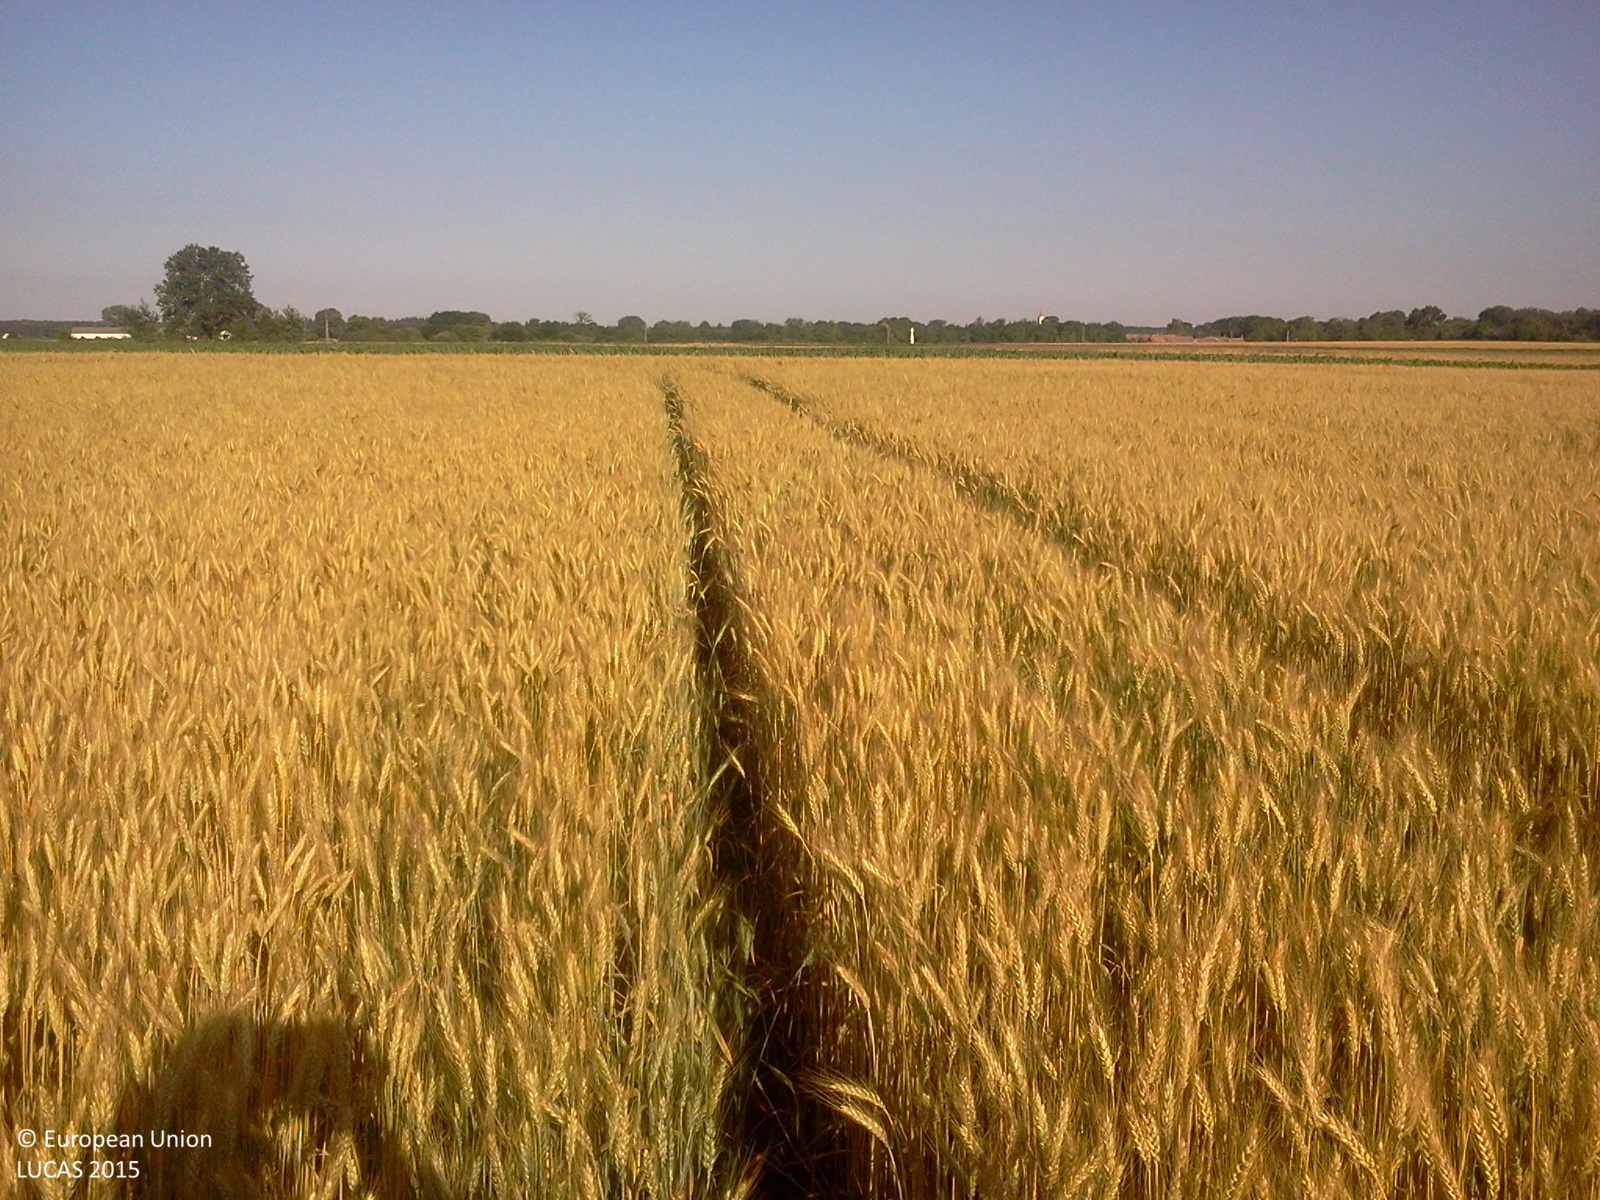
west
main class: Cropland
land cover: Durum wheat
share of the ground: > 75 %
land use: Agriculture (excluding fallow land and kitchen gardens)
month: June
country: HU
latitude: 47.0515
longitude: 17.1531
